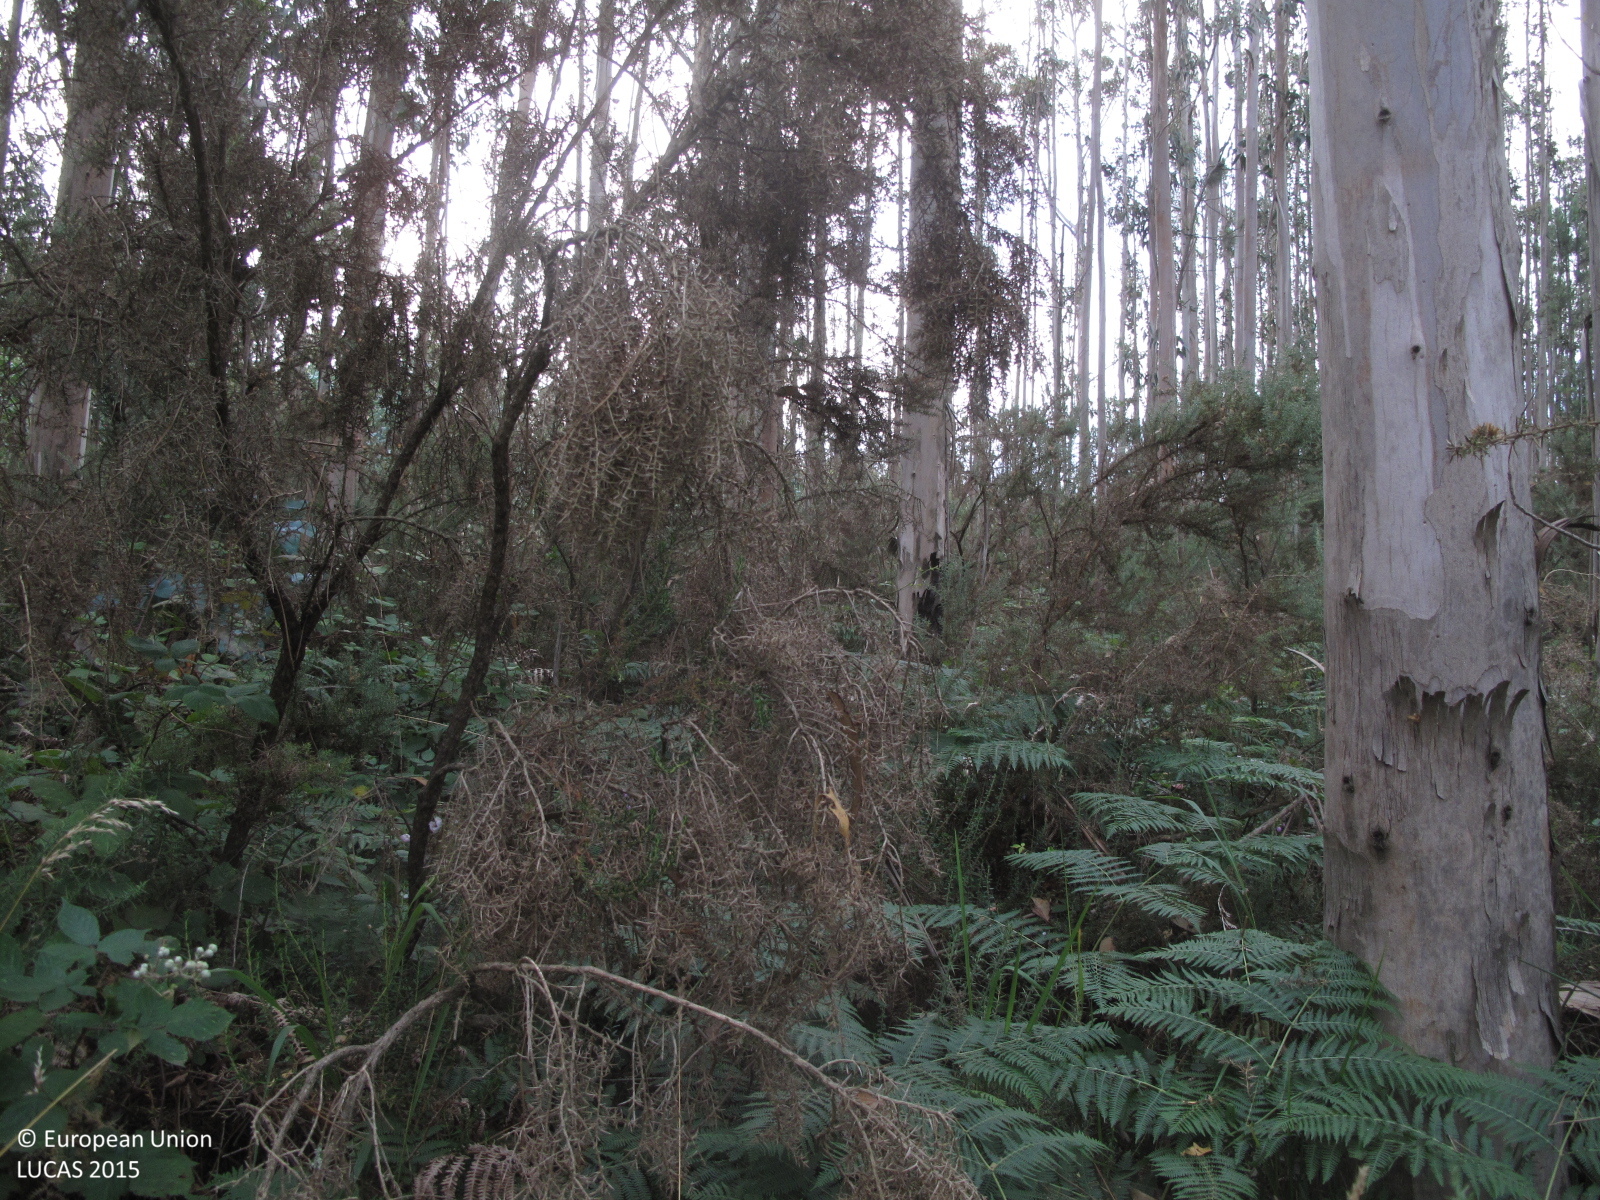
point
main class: Woodland
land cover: Broadleaved woodland
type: exotic forest
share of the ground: 25 - 50 %
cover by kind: shrubs 50 %, broadleaved forest trees 30 %, herbaceous plants 20 %
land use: Forestry
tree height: > 5 m
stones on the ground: < 10 %
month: July
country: ES
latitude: 43.1459
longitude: -8.7175
